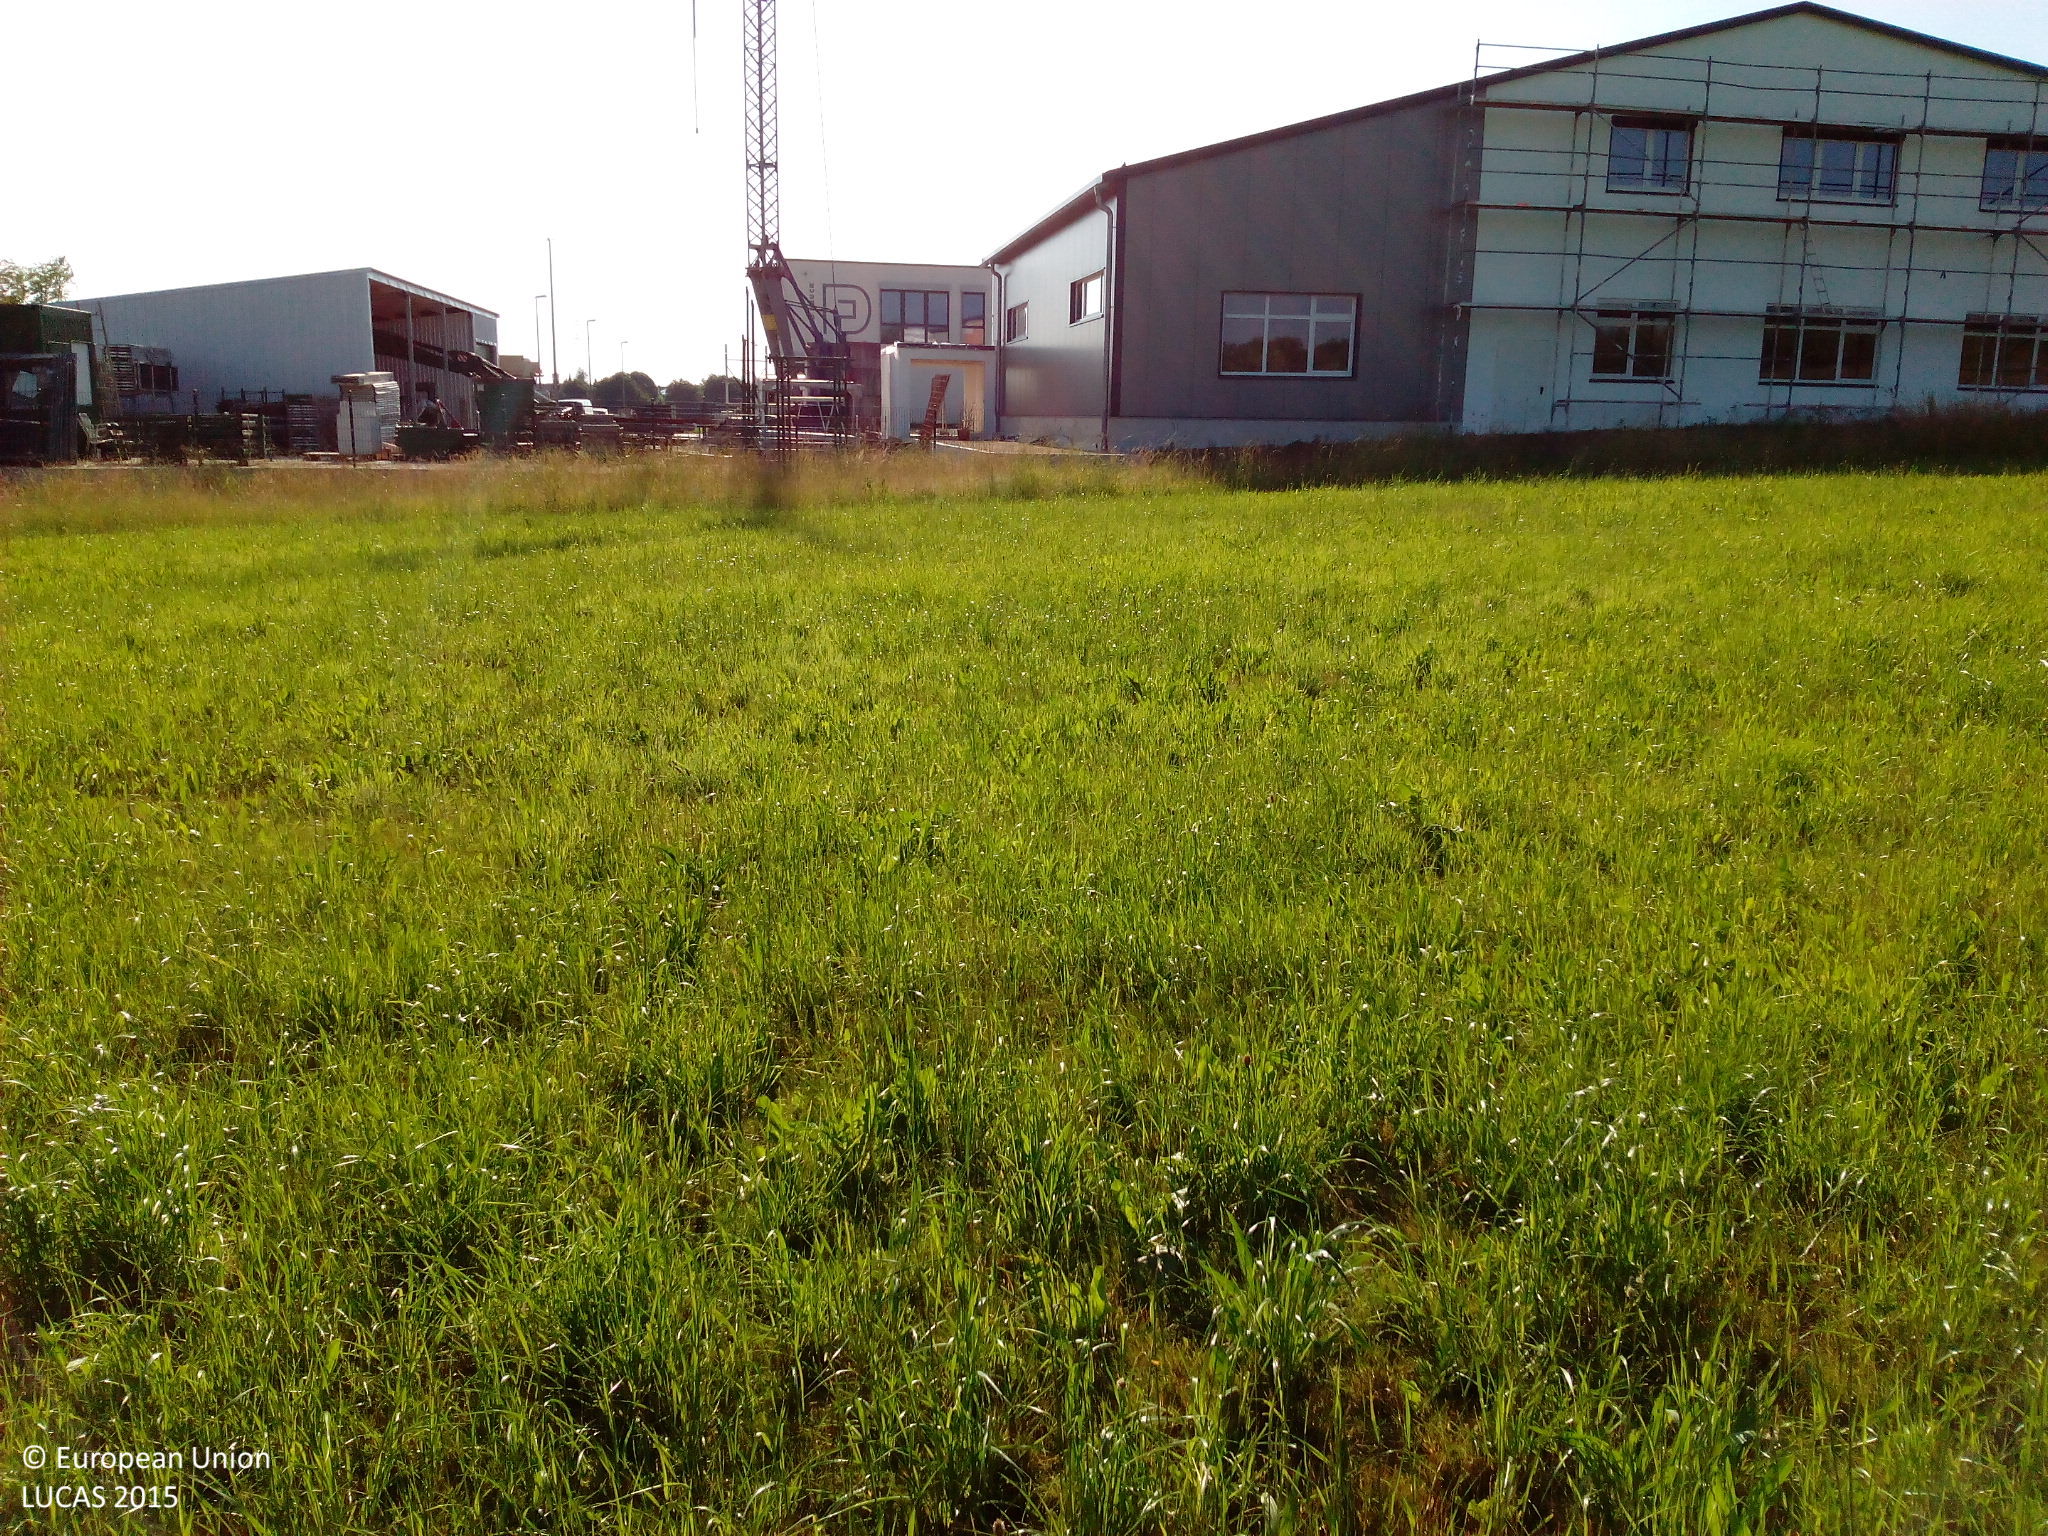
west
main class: Grassland
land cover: Grassland without tree/shrub cover
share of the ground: > 75 %
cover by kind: herbaceous plants 100 %
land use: Agriculture (excluding fallow land and kitchen gardens)
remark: Harvested field
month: June
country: DE
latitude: 48.9057
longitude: 9.4136
